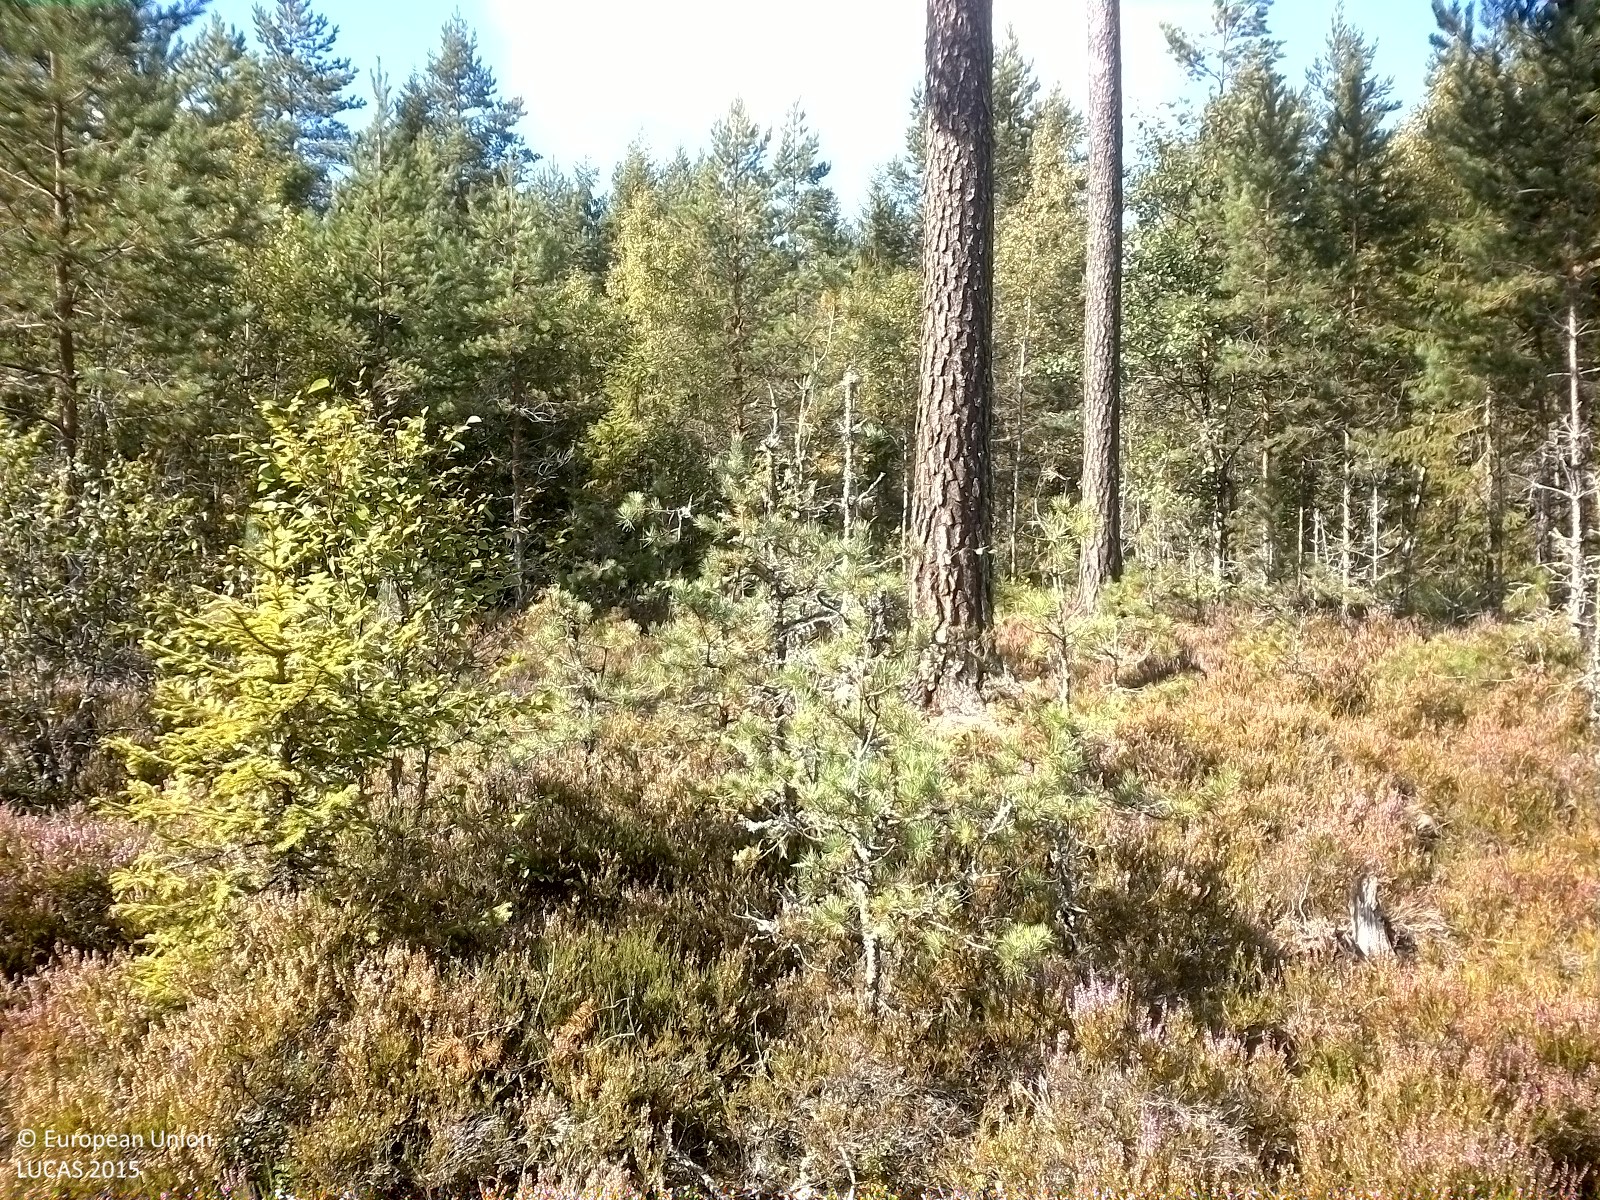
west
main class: Shrubland
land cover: Shrubland with sparse tree cover
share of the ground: 50 - 75 %
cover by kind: shrubs 70 %, lichens and mosses 20 %, coniferous forest trees 5 %, herbaceous plants 5 %
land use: Semi-natural and natural areas not in use
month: August
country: SE
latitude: 59.0730
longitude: 15.6970
